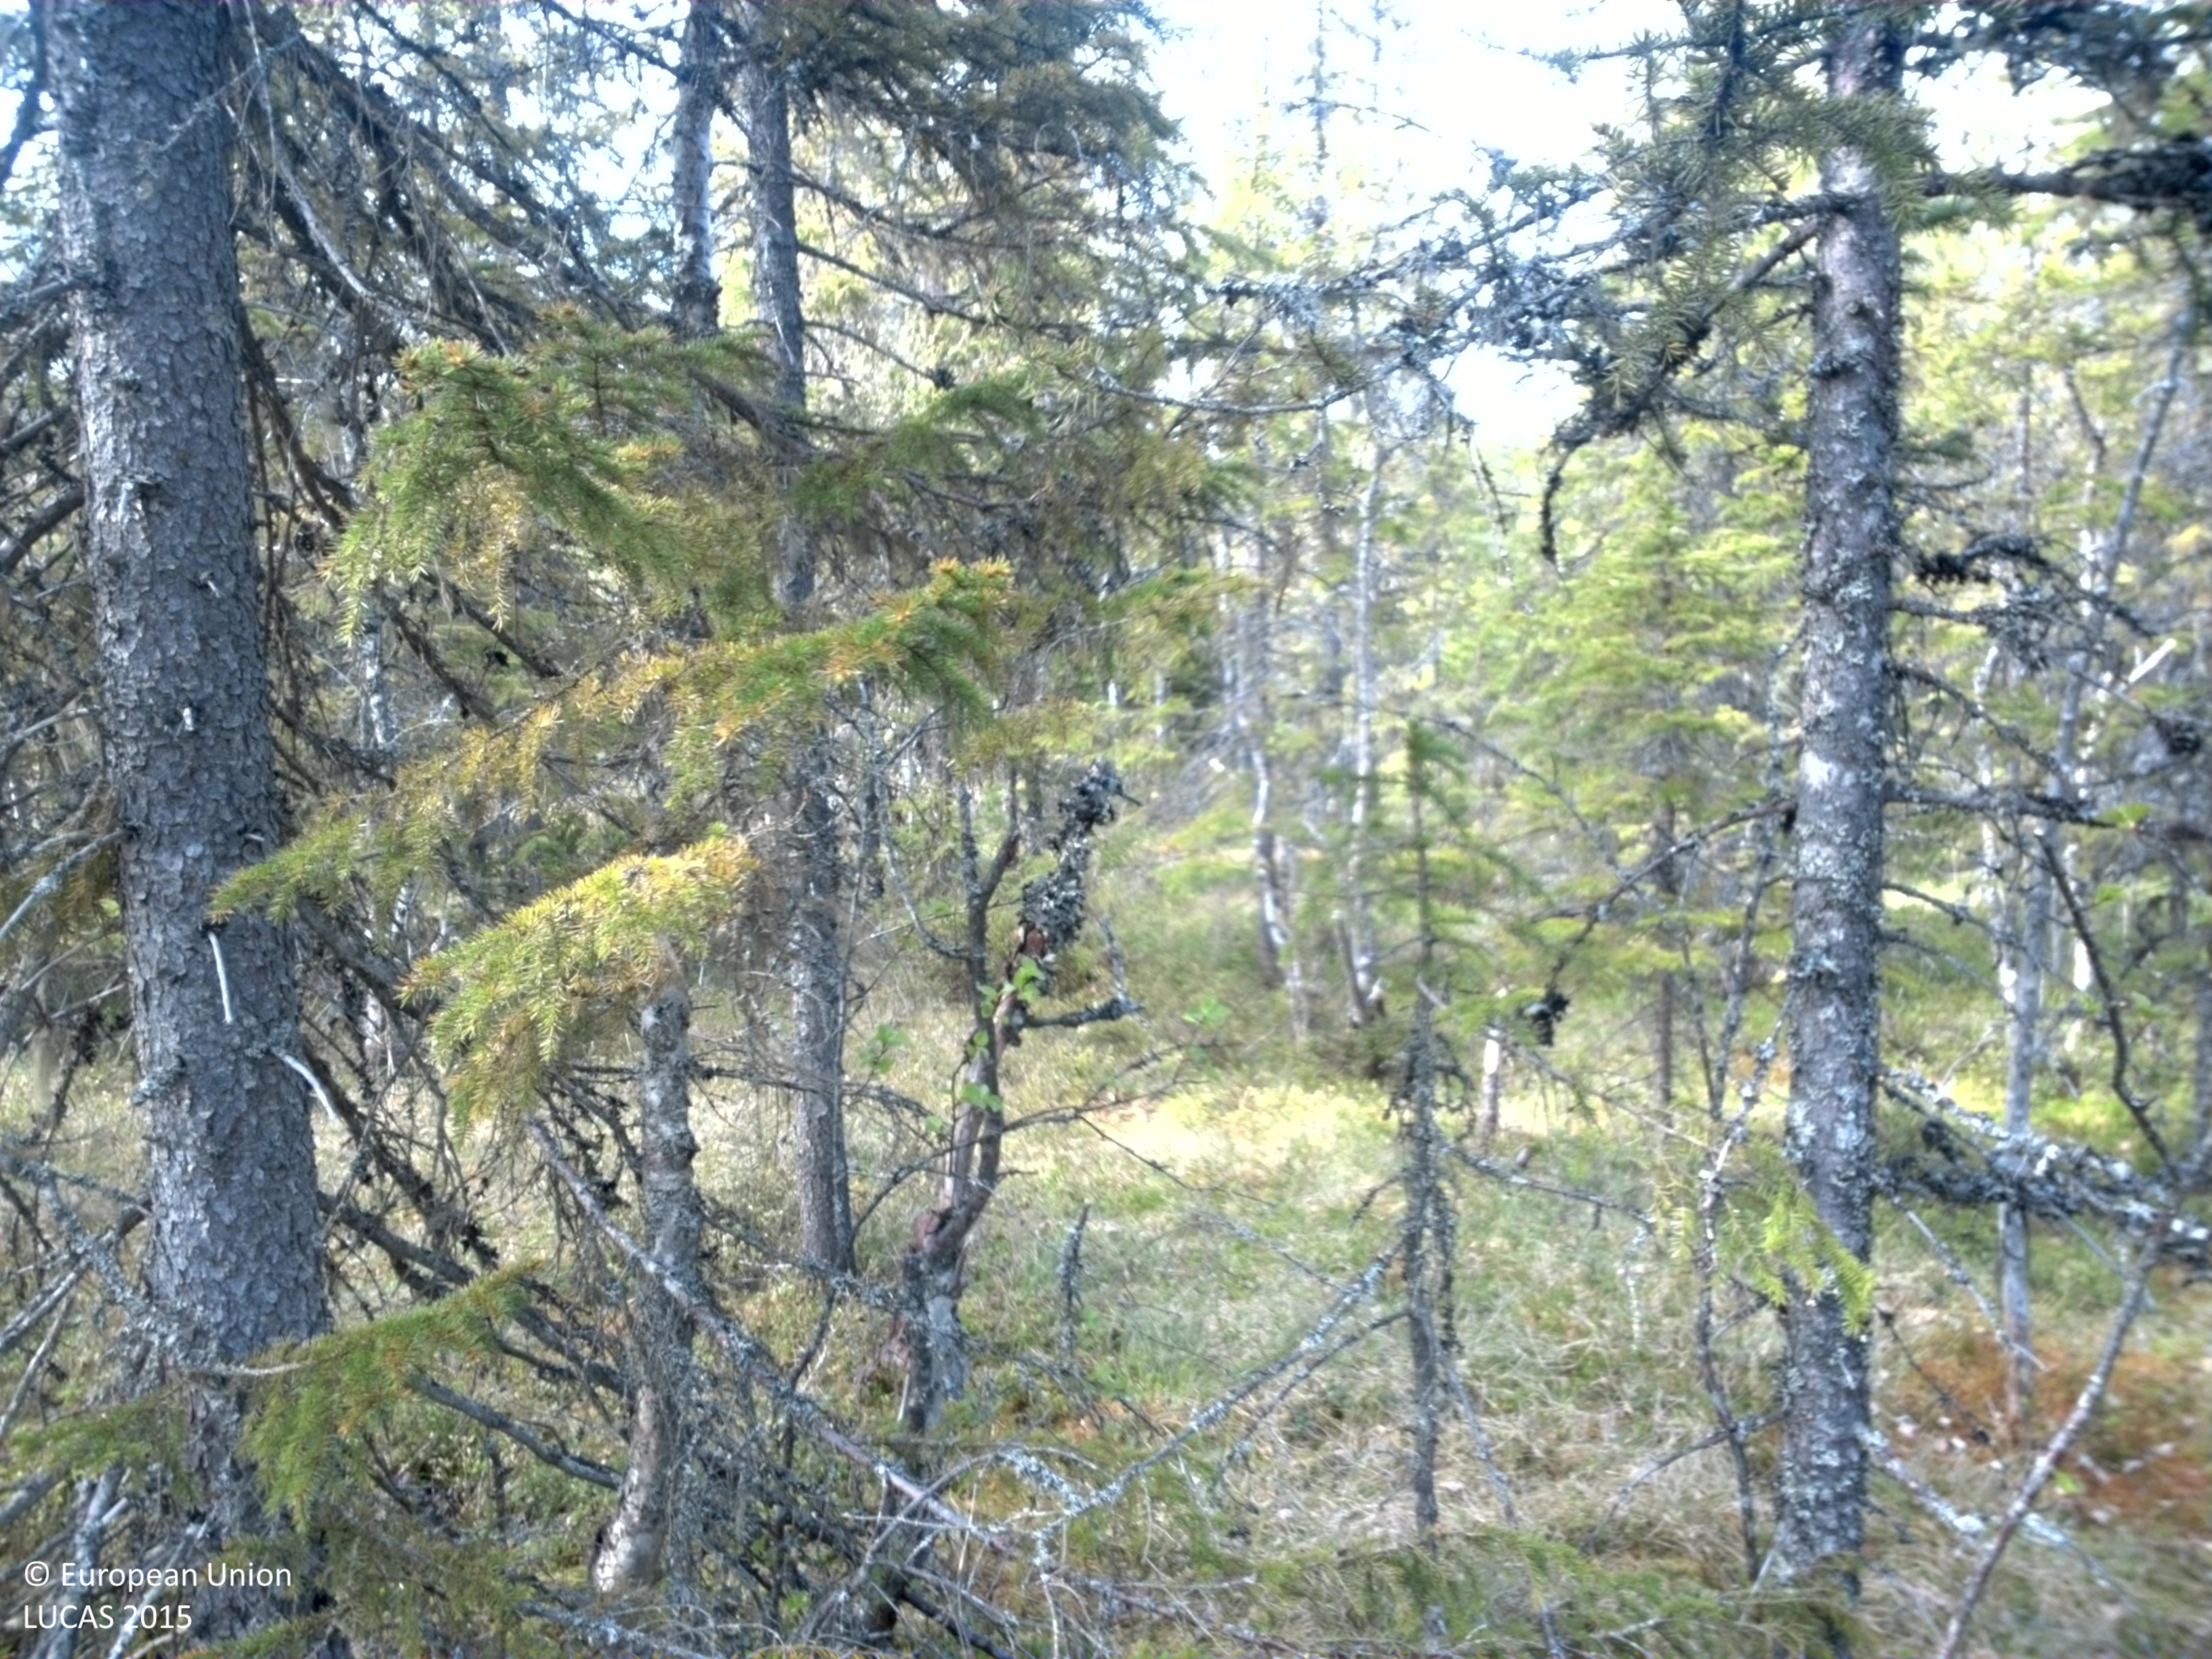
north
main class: Woodland
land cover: Spruce dominated coniferous woodland
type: boreal forest
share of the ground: 50 - 75 %
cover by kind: coniferous forest trees 45 %, shrubs 20 %, lichens and mosses 20 %, broadleaved forest trees 15 %
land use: Semi-natural and natural areas not in use
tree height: > 5 m
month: June
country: SE
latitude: 61.1527
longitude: 13.2403
